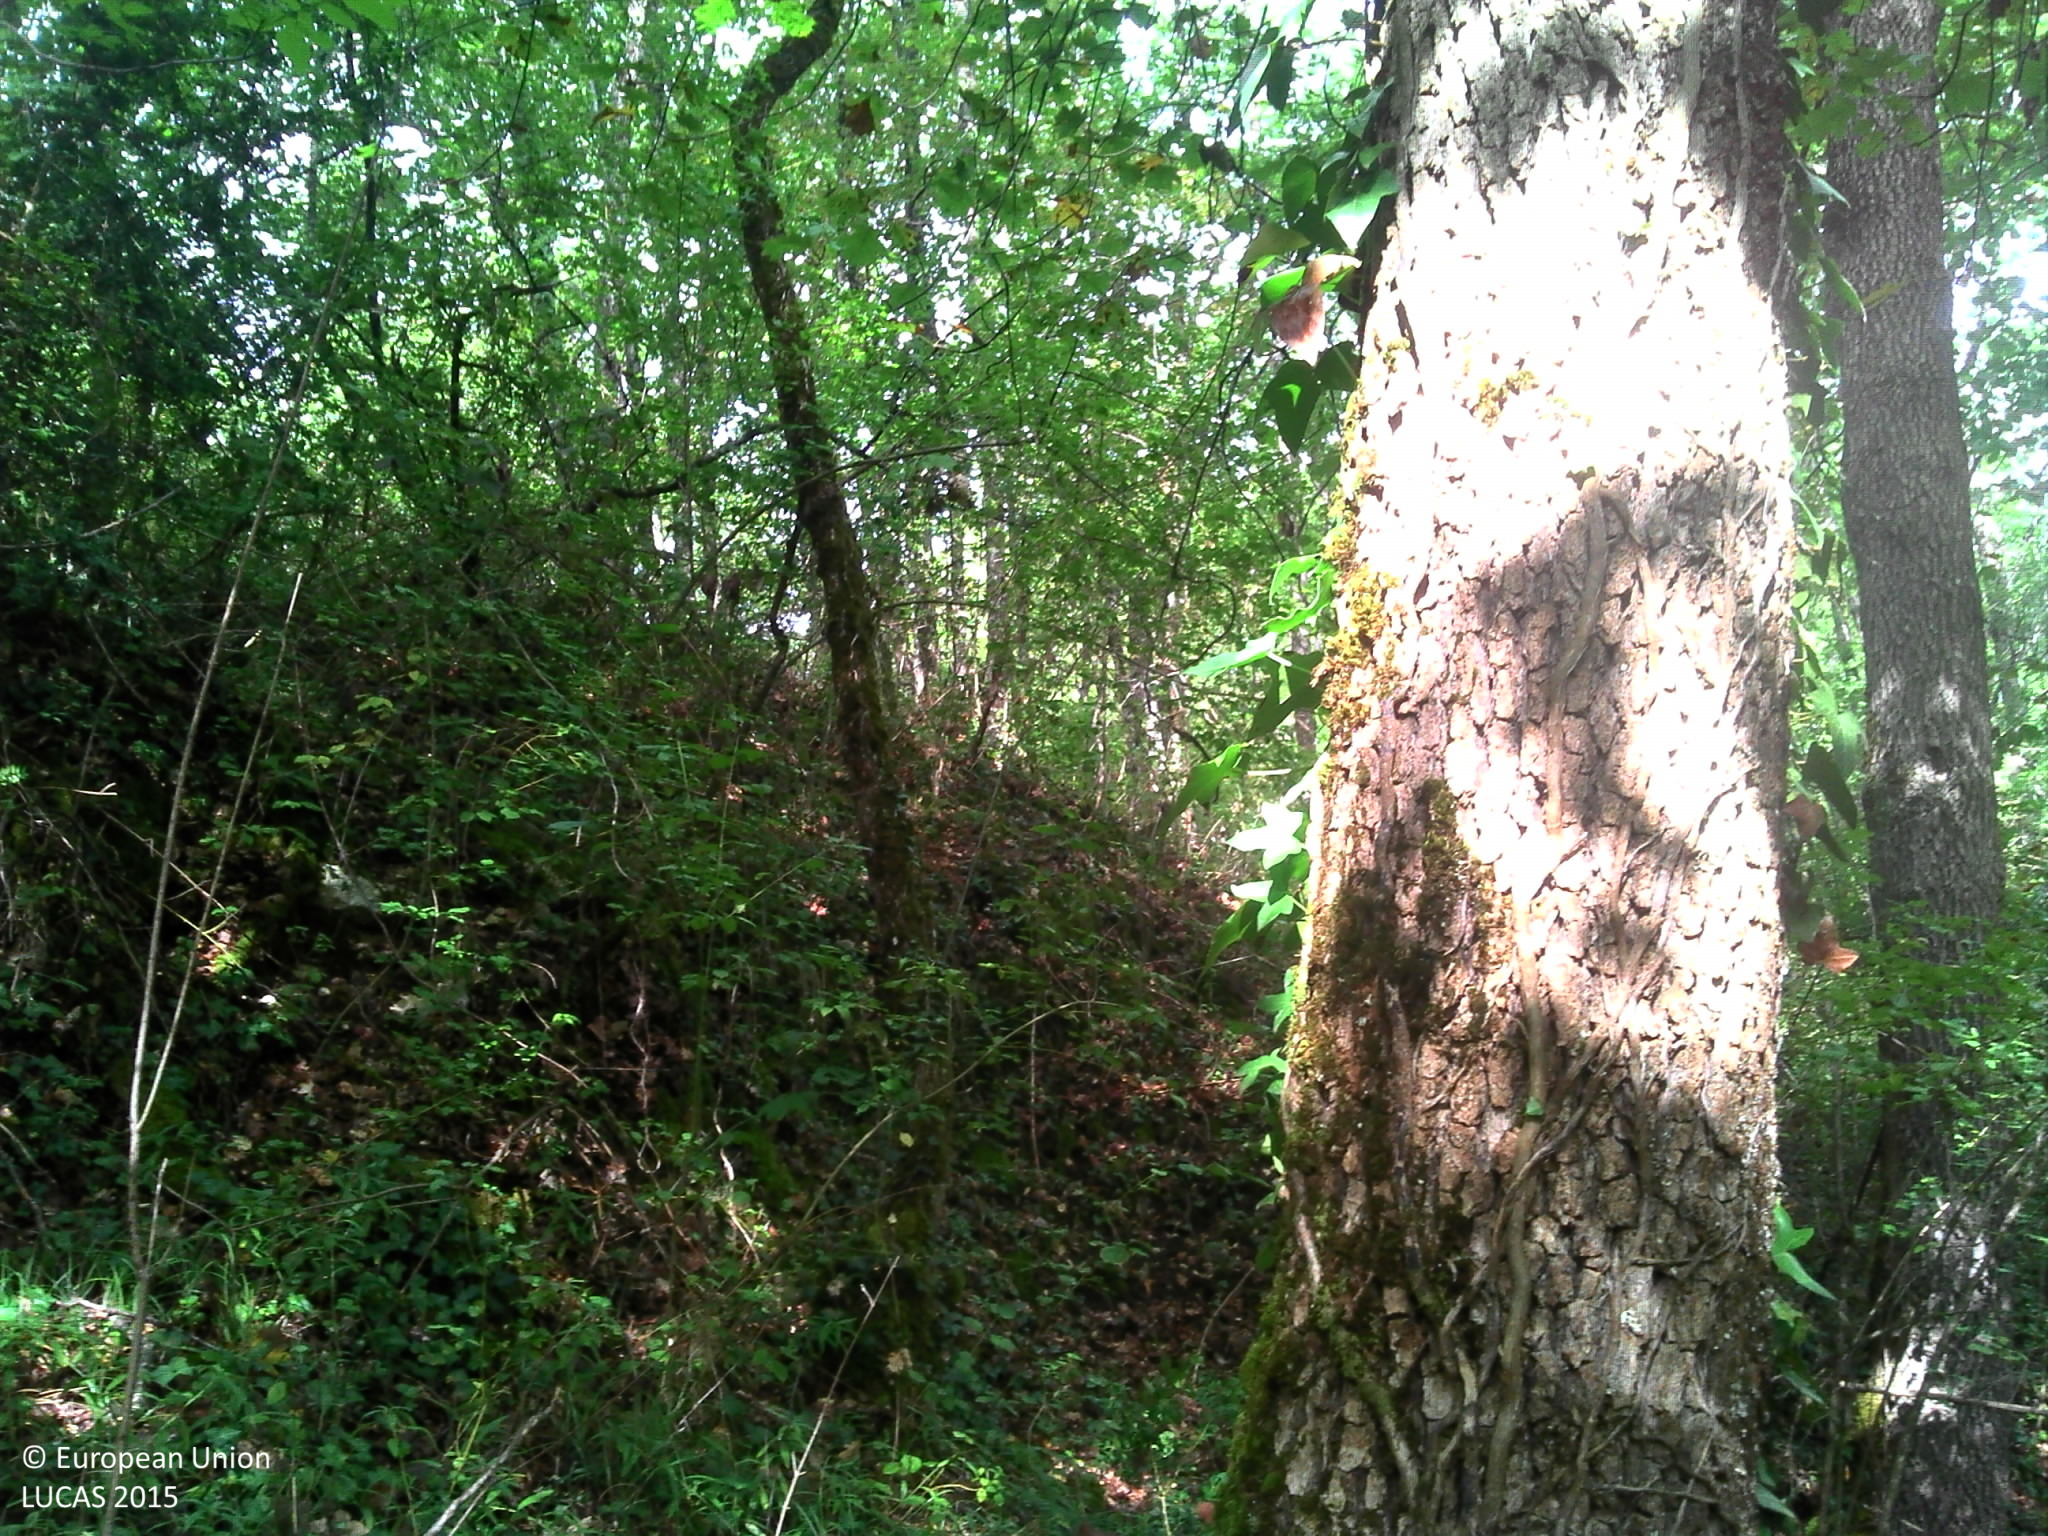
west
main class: Woodland
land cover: Broadleaved woodland
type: mesophytic deciduous forest
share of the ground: > 75 %
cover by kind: broadleaved forest trees 80 %, shrubs 10 %, herbaceous plants 10 %
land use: Forestry
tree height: > 5 m
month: August
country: FR
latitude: 44.2581
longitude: 1.3184
